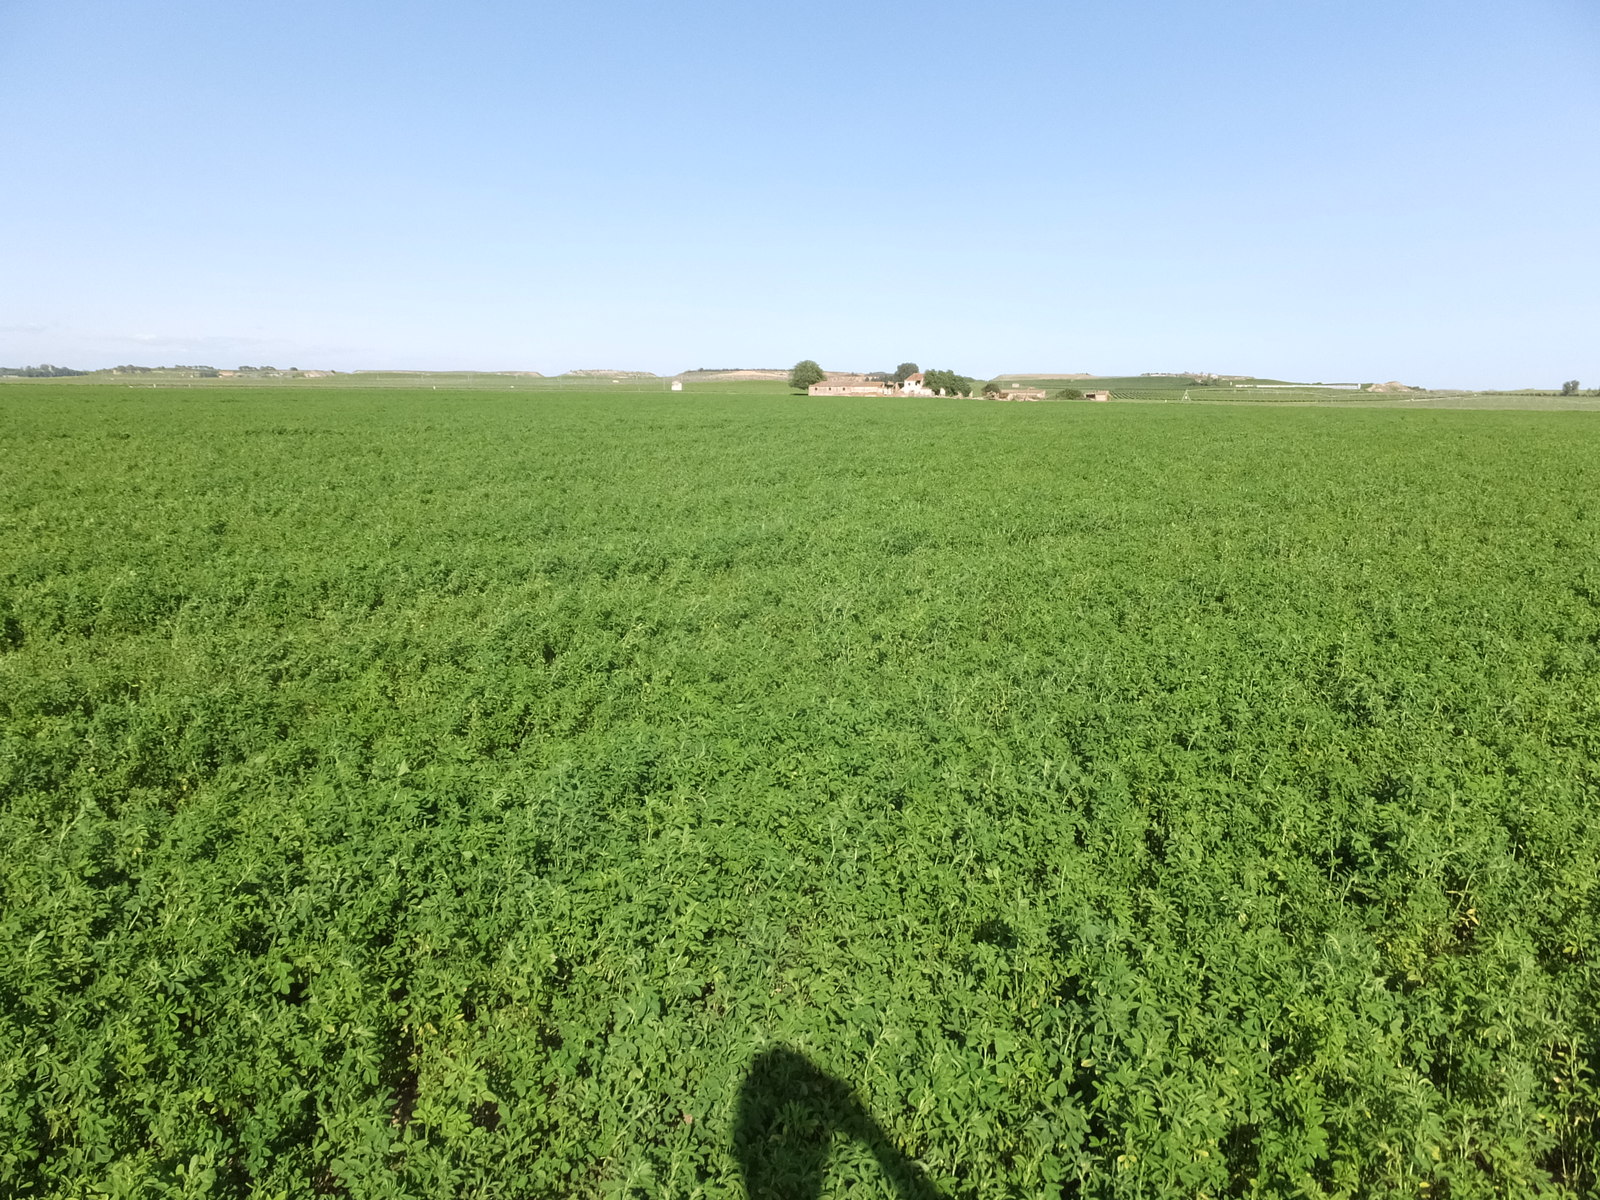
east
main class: Cropland
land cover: Lucerne
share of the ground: > 75 %
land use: Agriculture (excluding fallow land and kitchen gardens)
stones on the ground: < 10 %
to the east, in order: Lucerne
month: May
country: ES
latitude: 41.6555
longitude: 0.4399
